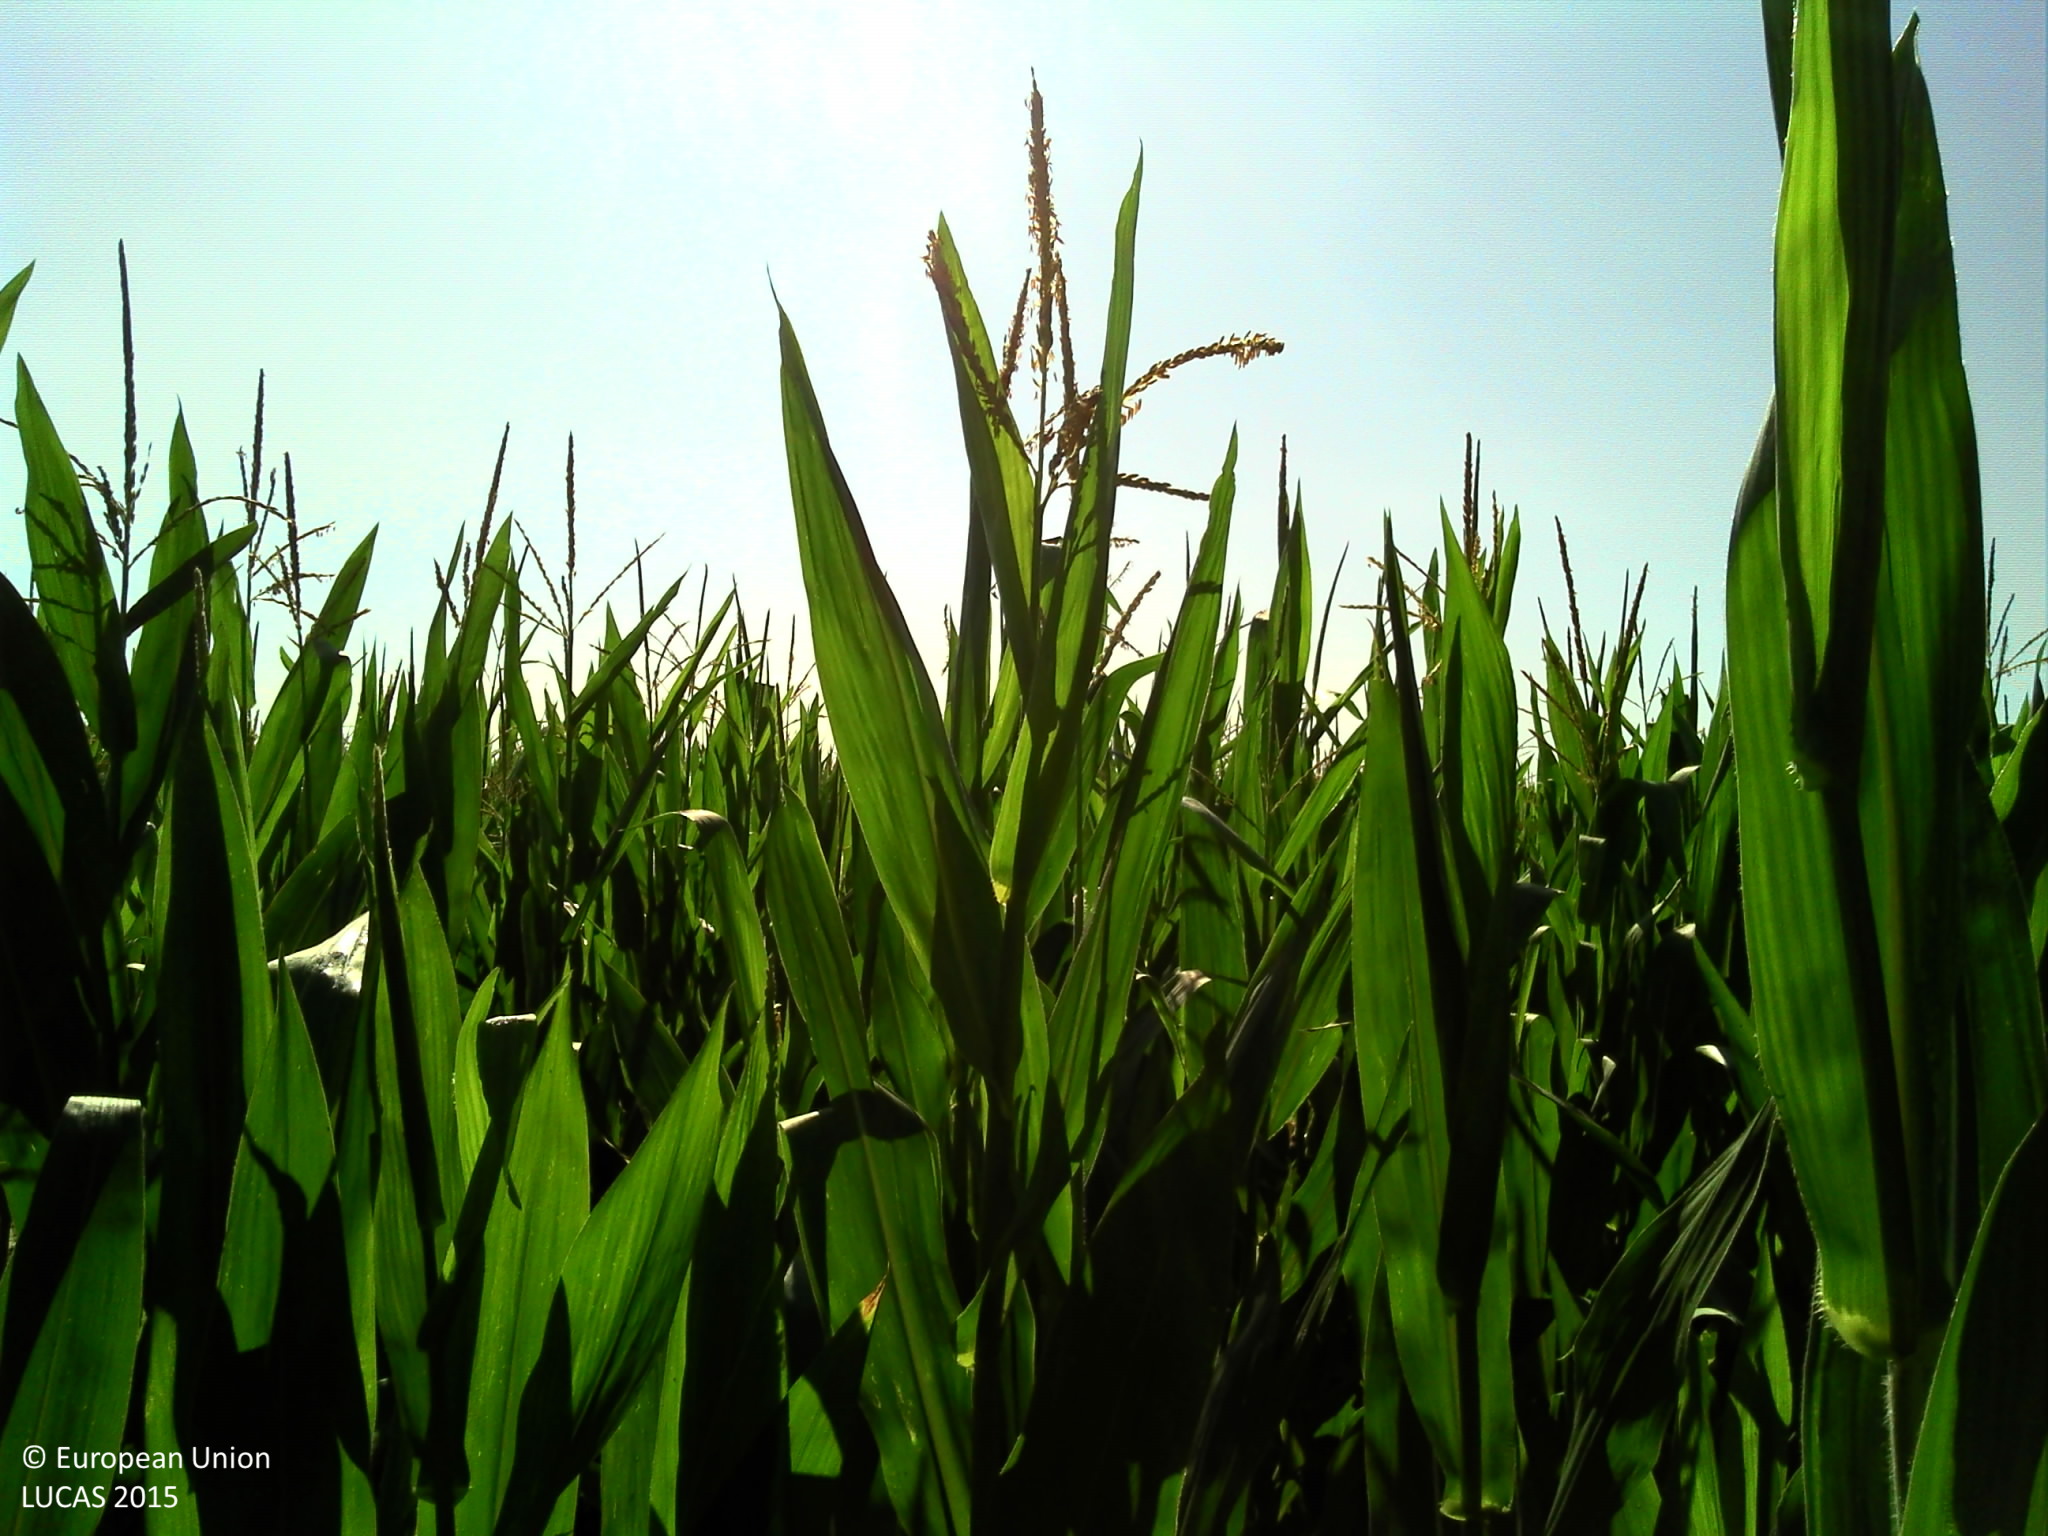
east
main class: Cropland
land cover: Maize
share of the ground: > 75 %
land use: Agriculture (excluding fallow land and kitchen gardens)
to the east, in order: Maize
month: July
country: FR
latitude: 45.7550
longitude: 4.1016
